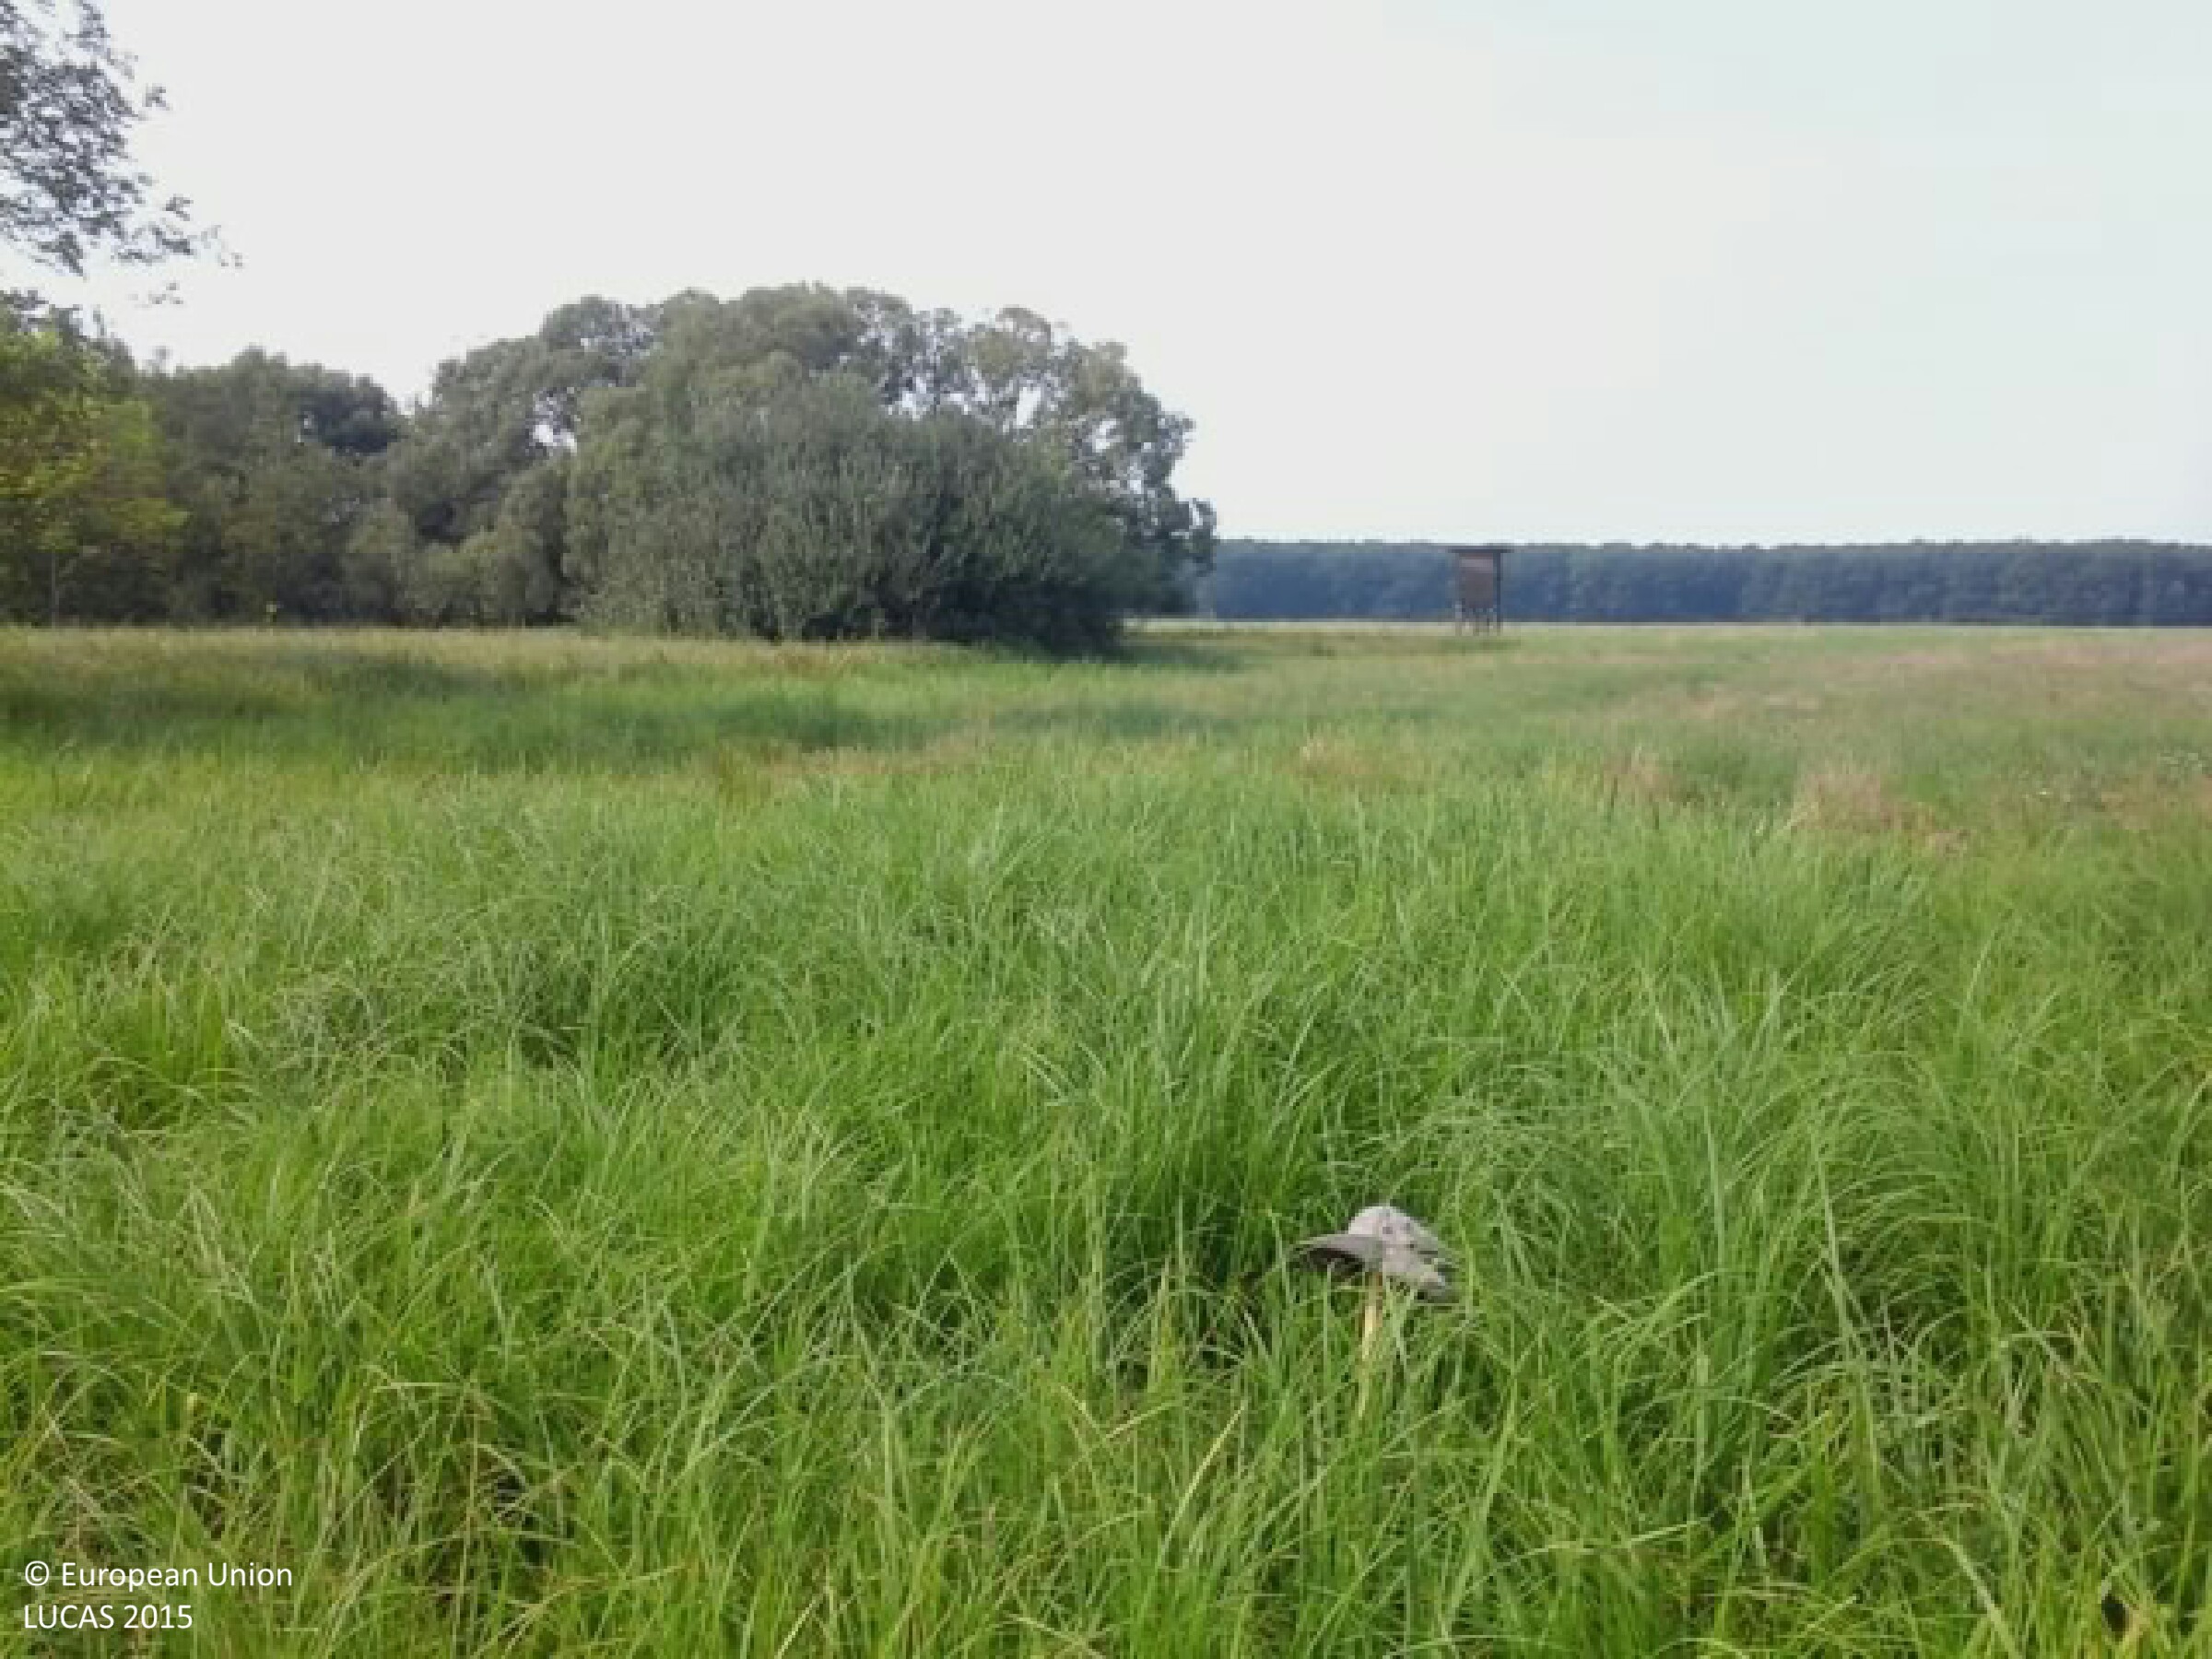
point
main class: Grassland
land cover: Grassland without tree/shrub cover
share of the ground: > 75 %
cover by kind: herbaceous plants 100 %
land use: Semi-natural and natural areas not in use
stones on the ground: < 10 %
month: August
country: HU
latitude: 46.4910
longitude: 17.1559
